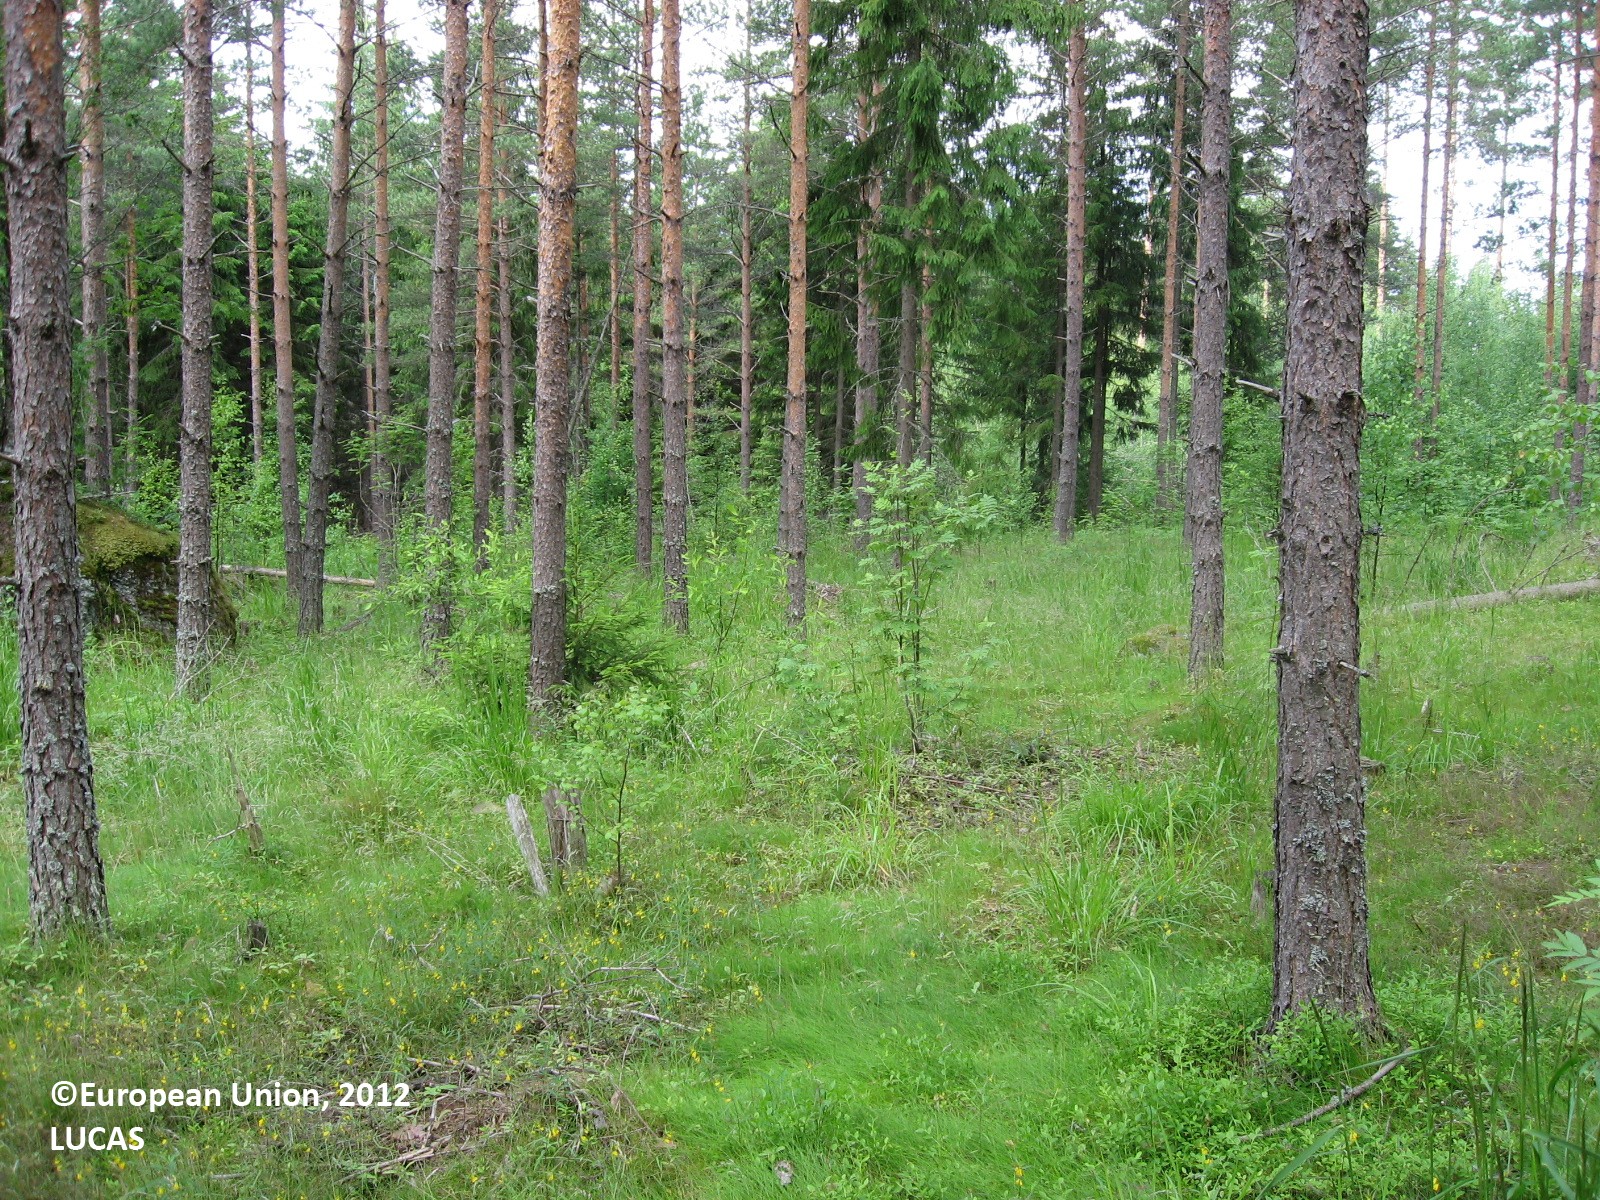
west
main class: Woodland
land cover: Pine dominated coniferous woodland
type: boreal forest
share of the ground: 25 - 50 %
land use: Forestry
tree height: > 5 m
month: June
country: FI
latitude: 60.6926
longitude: 26.5093
